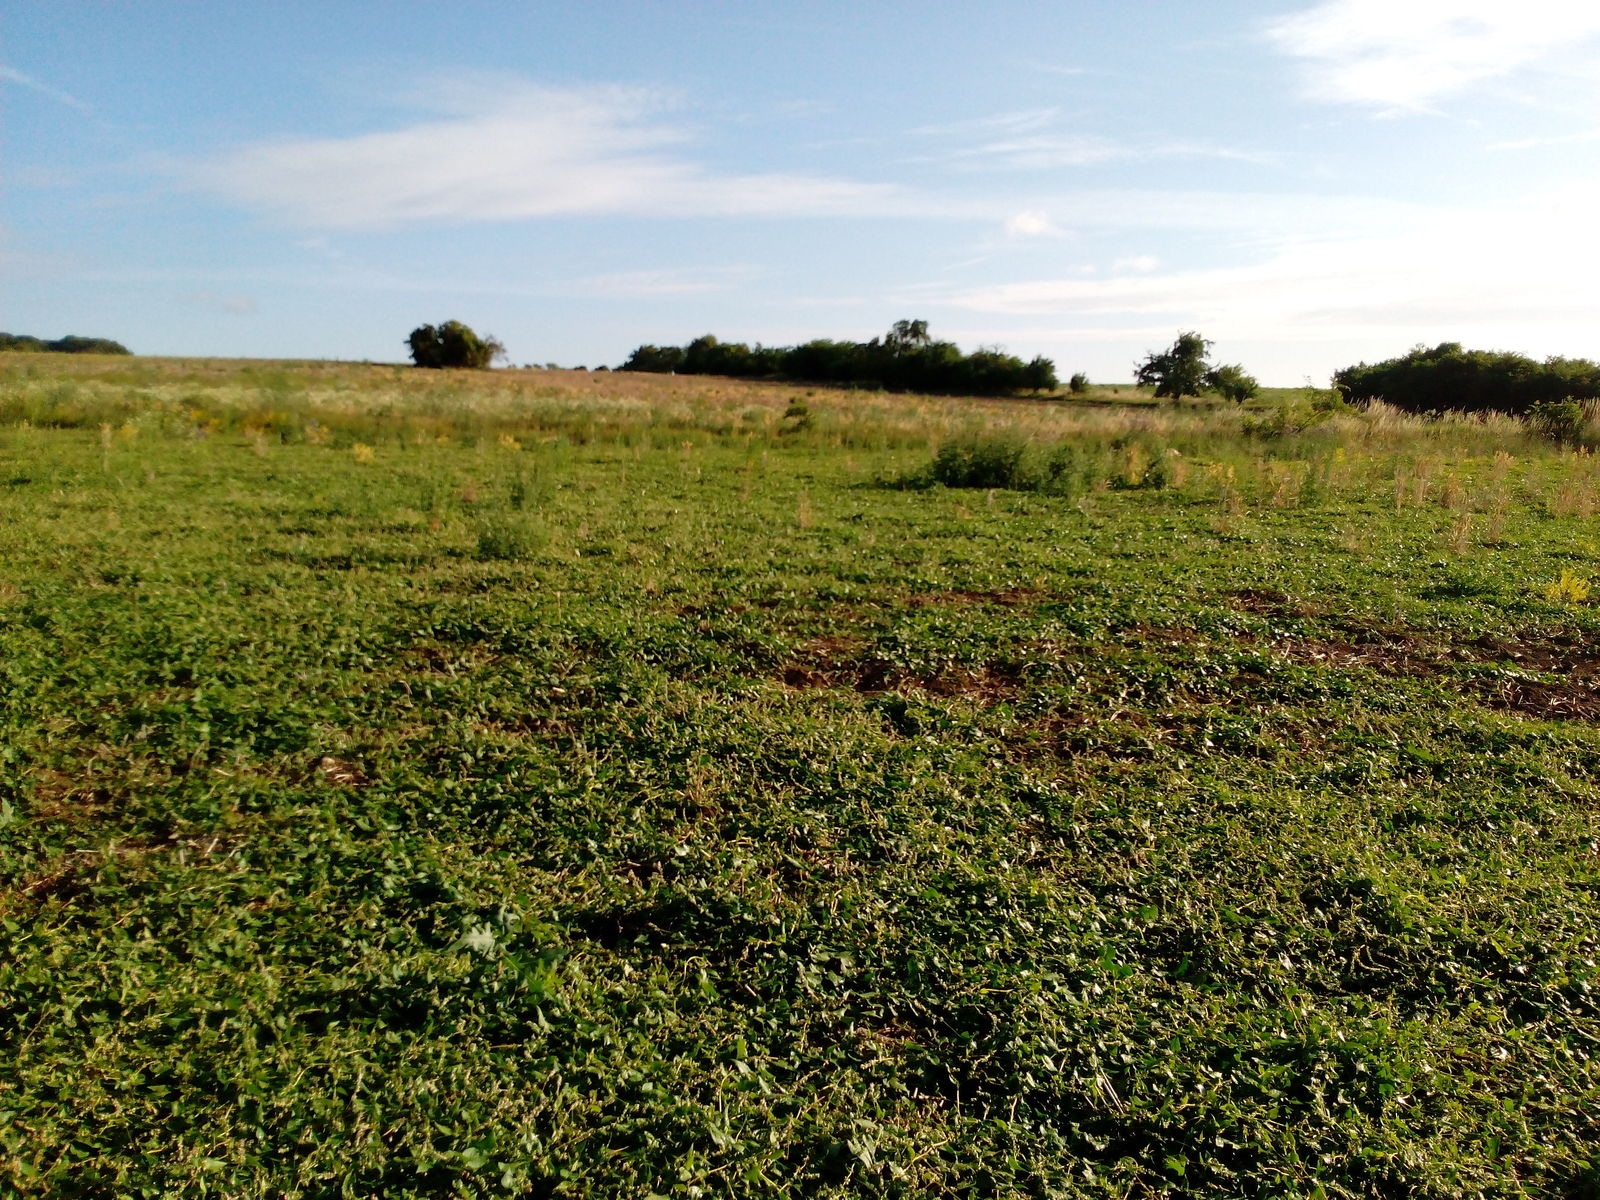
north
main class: Grassland
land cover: Spontaneously vegetated surfaces
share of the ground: > 75 %
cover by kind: herbaceous plants 100 %
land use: Fallow land
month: July
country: DE
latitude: 51.2952
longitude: 10.9319
